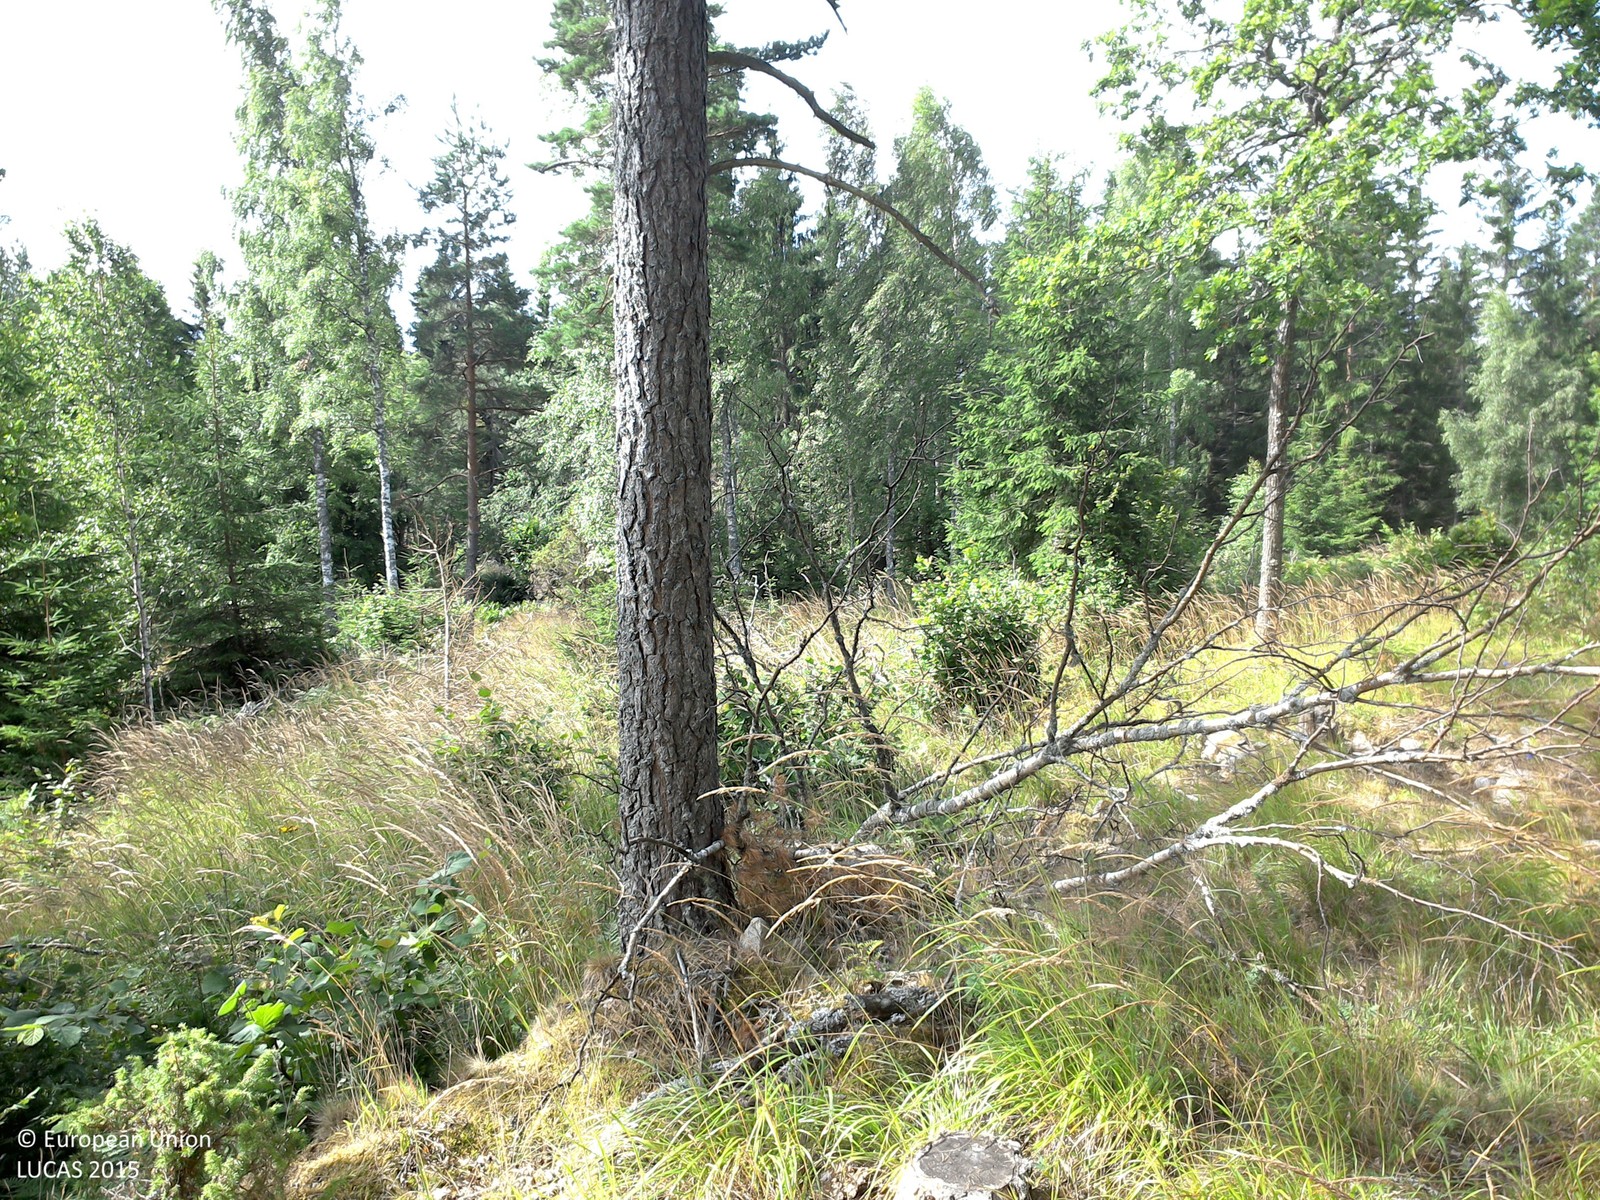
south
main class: Woodland
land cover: Pine dominated coniferous woodland
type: boreal forest
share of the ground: 50 - 75 %
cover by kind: coniferous forest trees 55 %, herbaceous plants 25 %, lichens and mosses 20 %
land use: Forestry
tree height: > 5 m
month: July
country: SE
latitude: 57.8848
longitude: 16.0515
